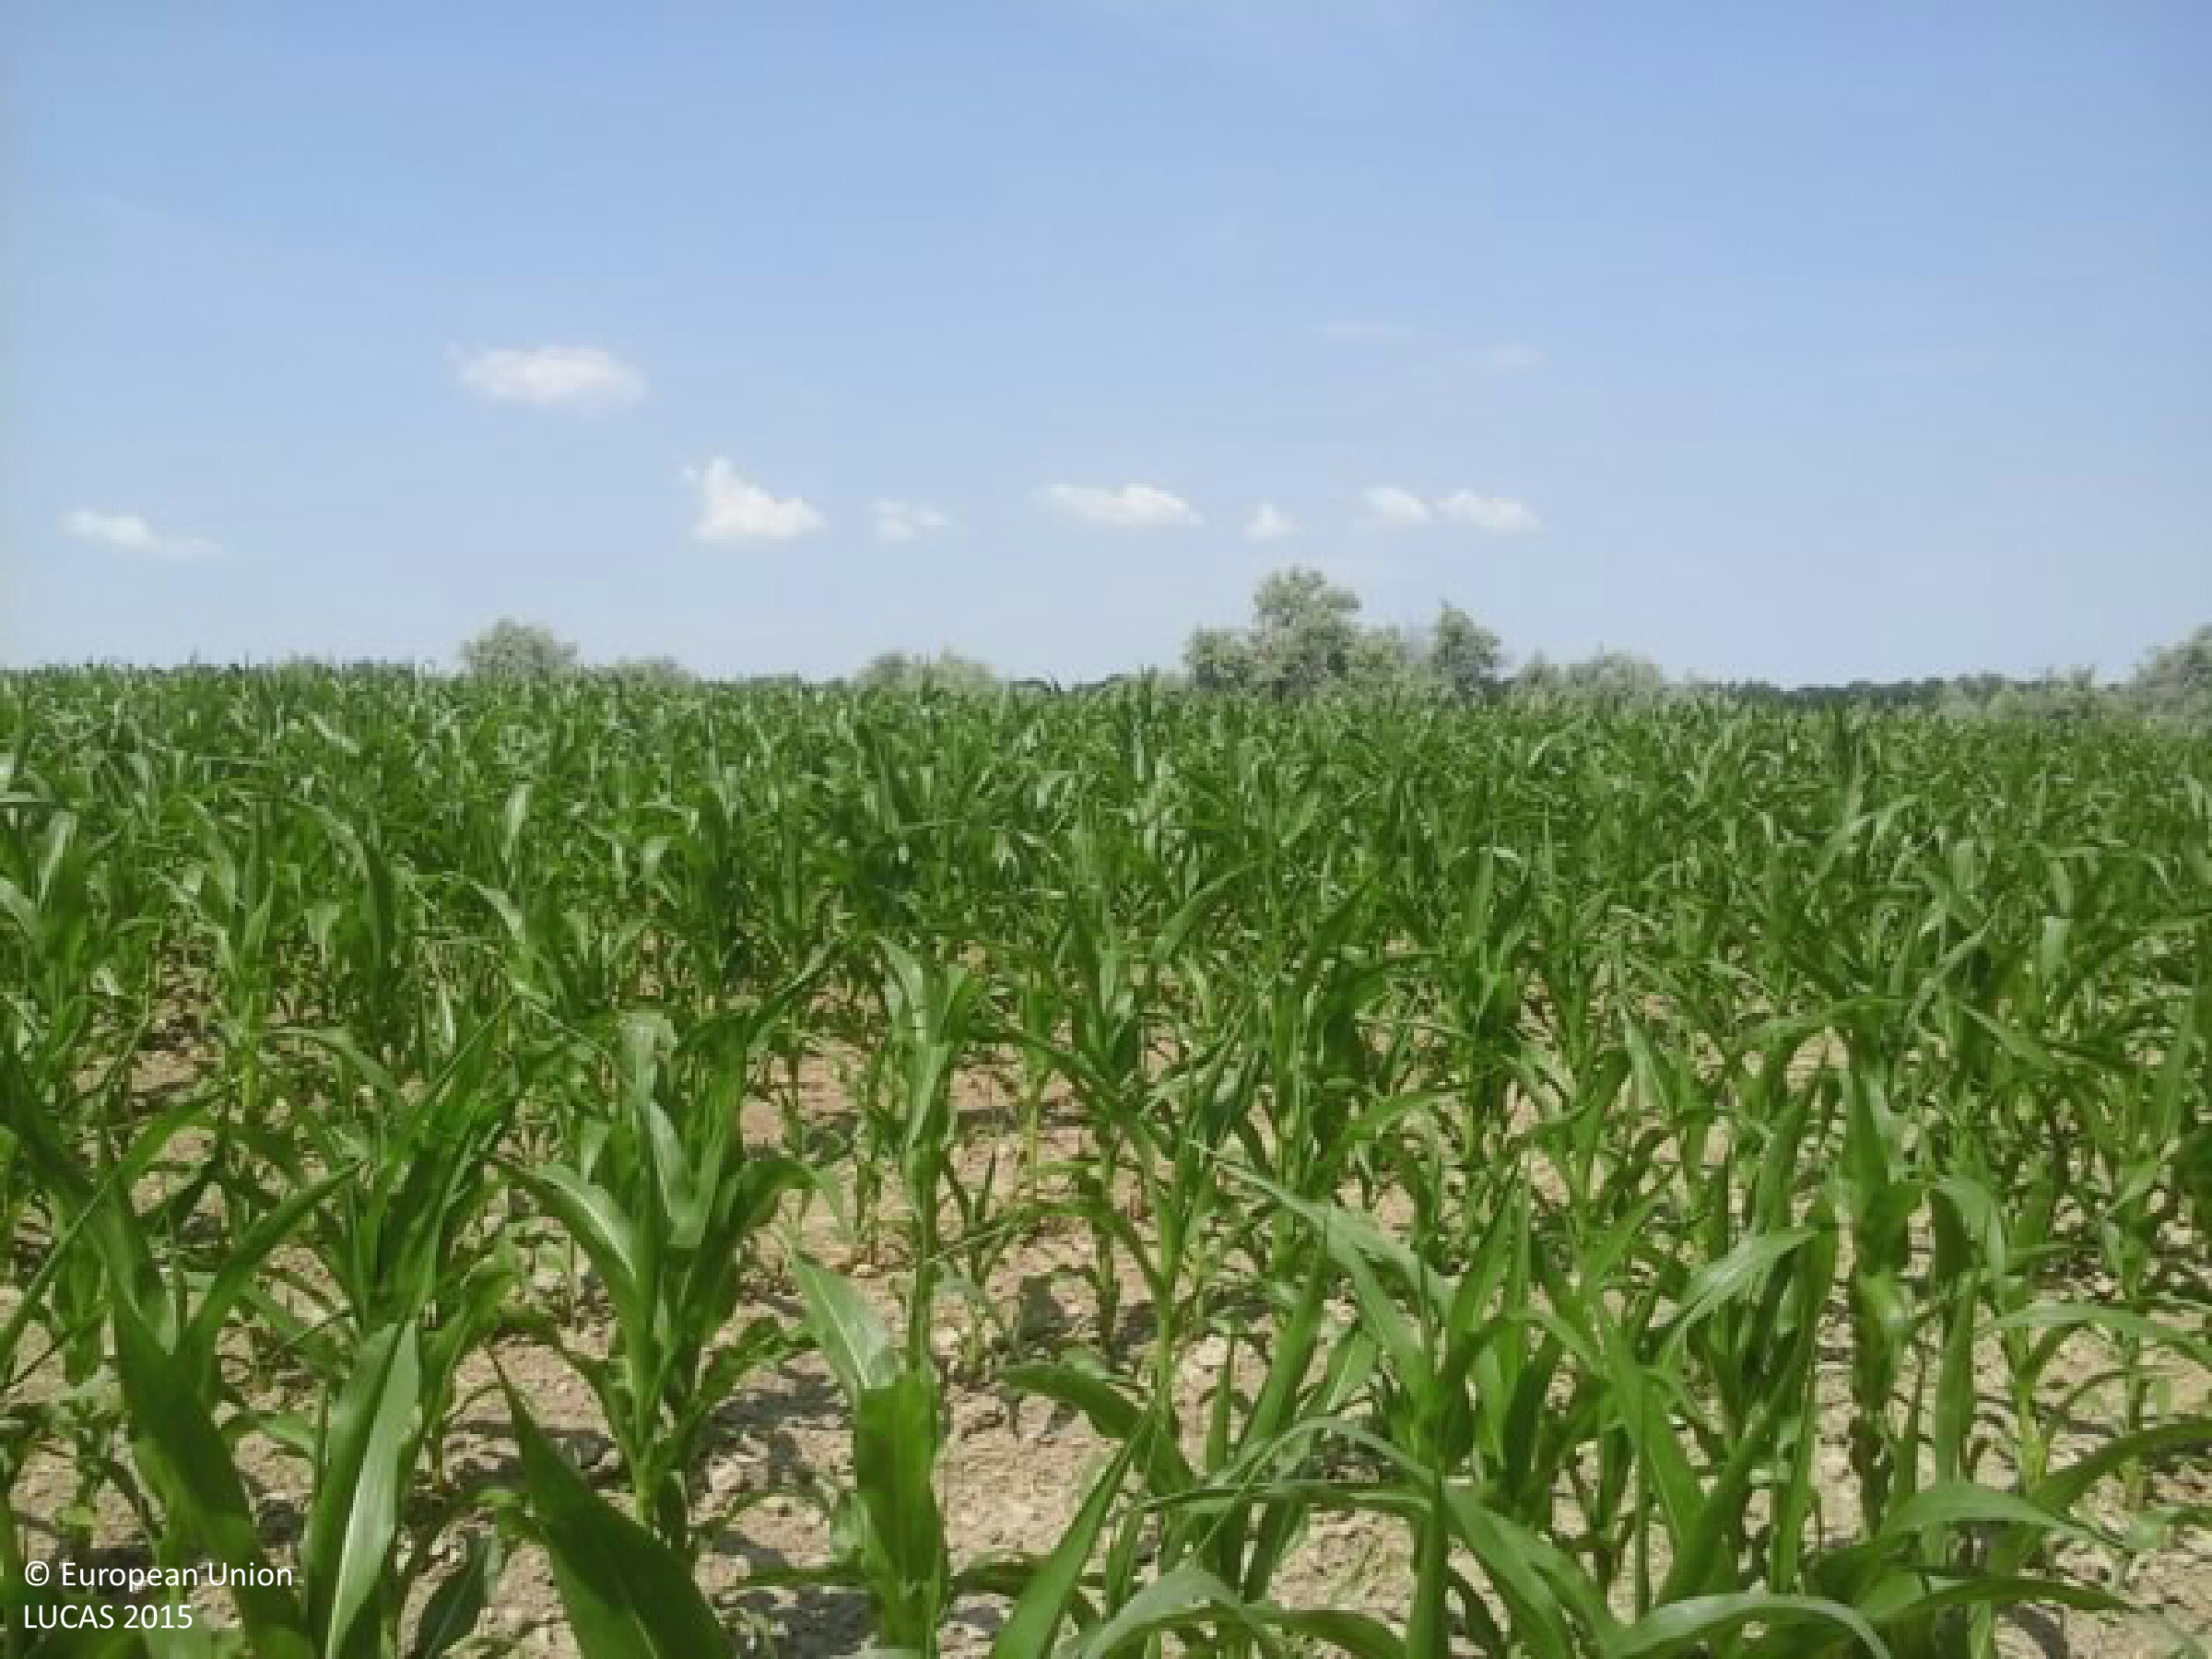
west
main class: Cropland
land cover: Maize
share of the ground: 50 - 75 %
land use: Agriculture (excluding fallow land and kitchen gardens)
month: July
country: HU
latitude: 46.7046
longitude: 18.8946
